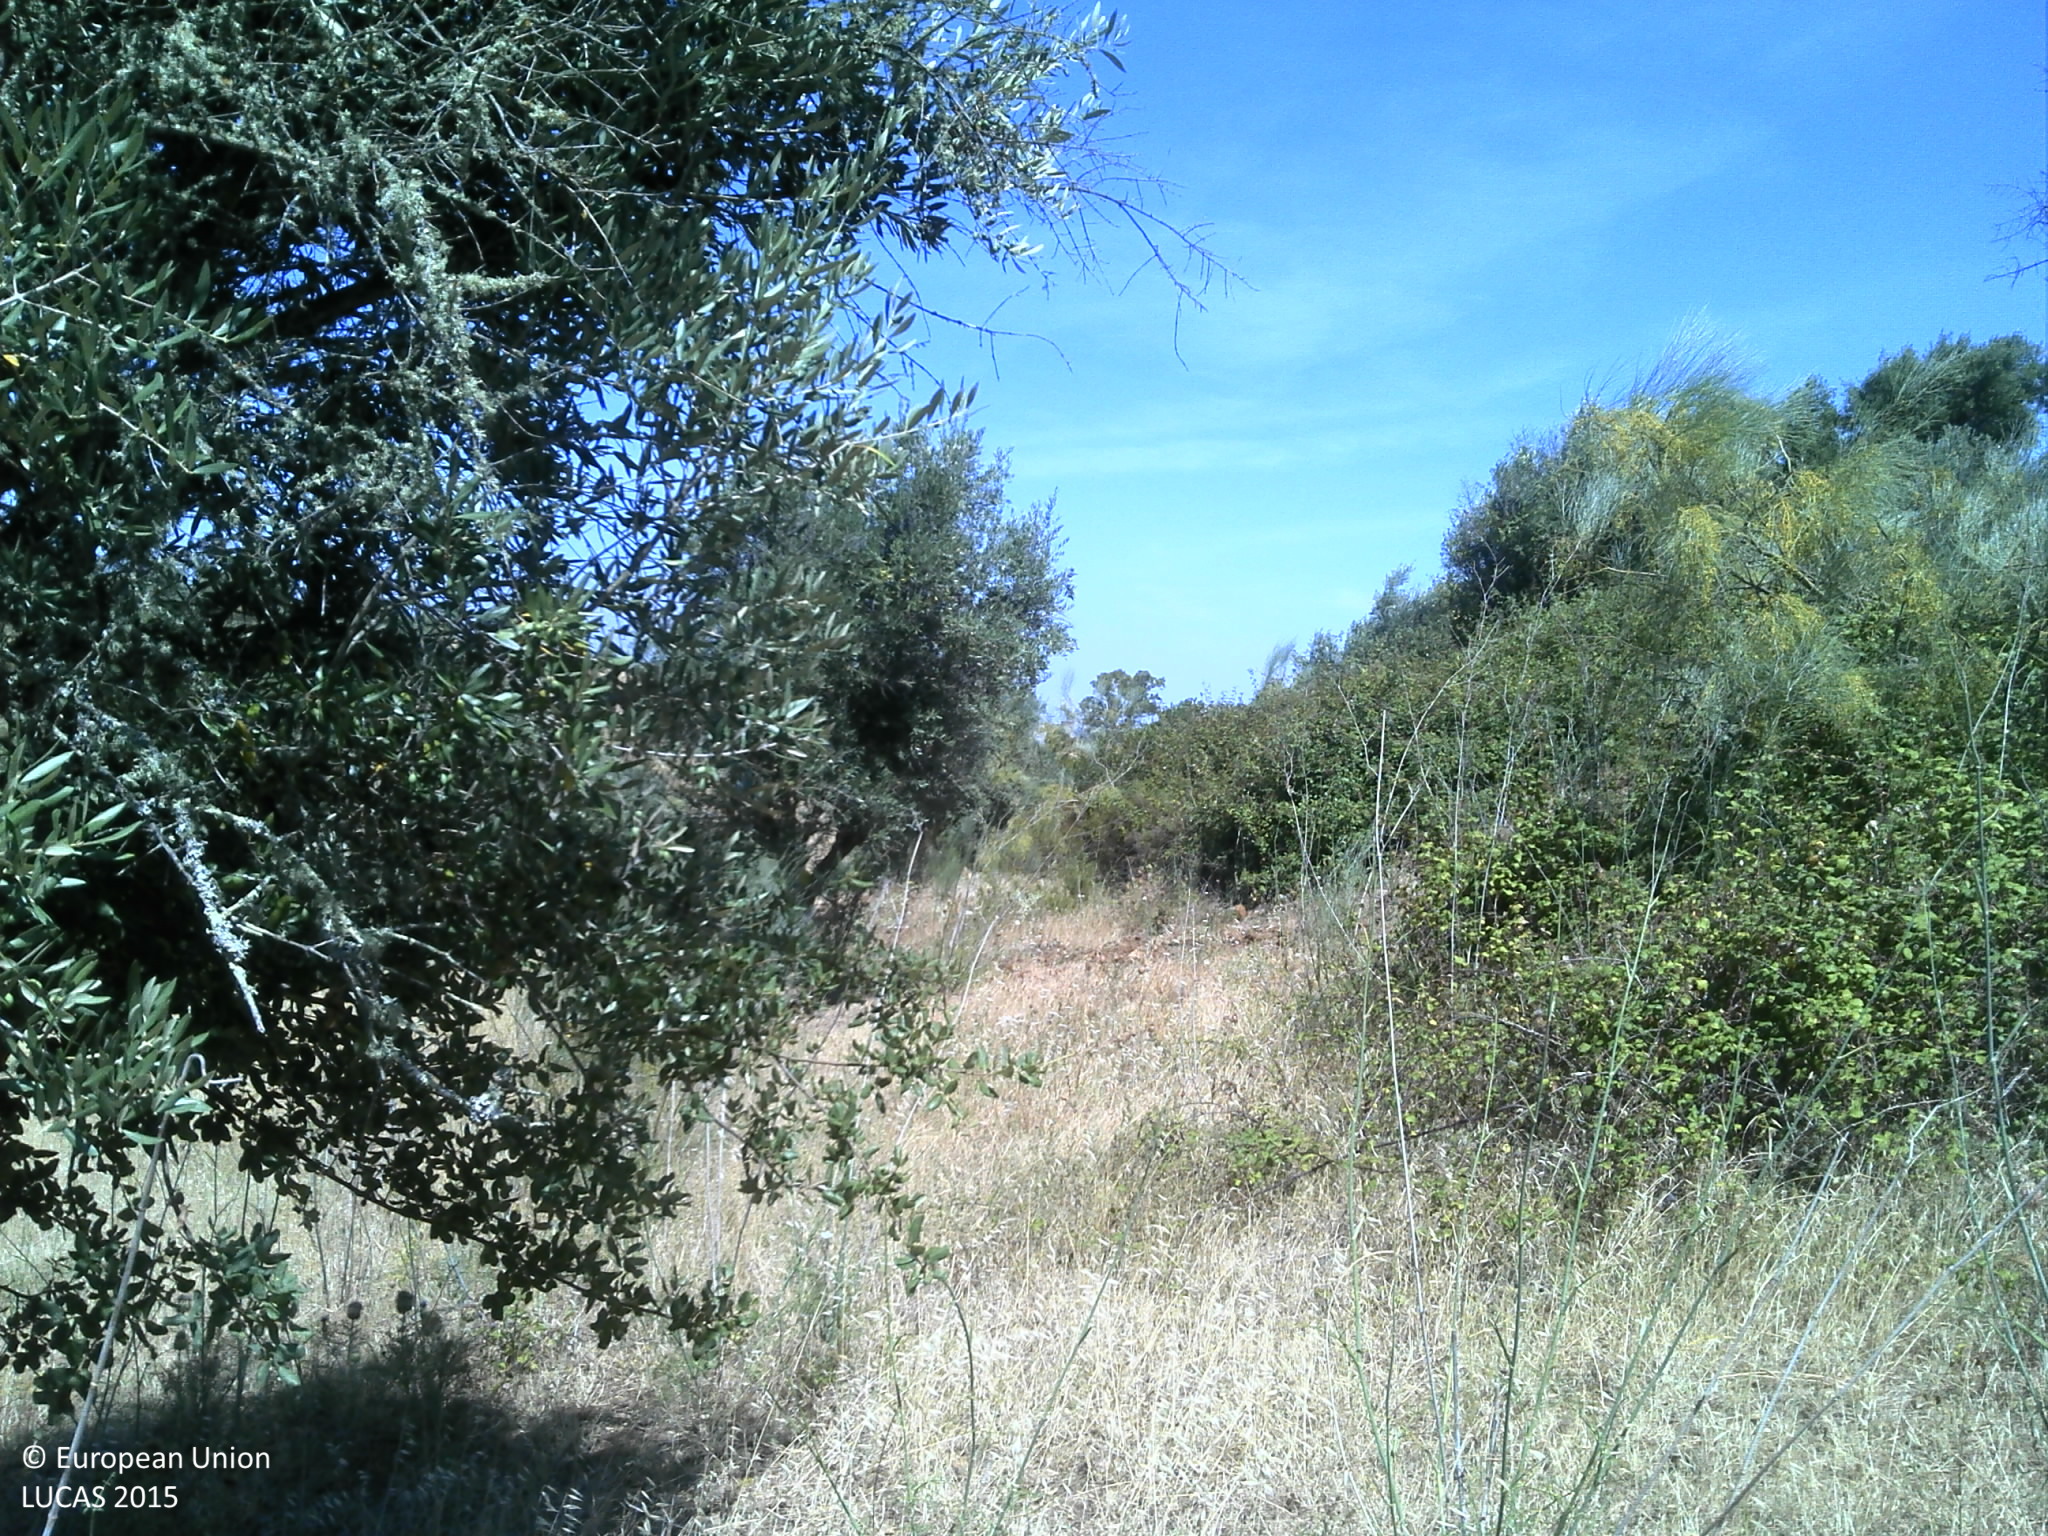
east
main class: Cropland
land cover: Olive groves
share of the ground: 25 - 50 %
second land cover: Grassland without tree/shrub cover
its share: 50 - 75 %
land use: Agriculture (excluding fallow land and kitchen gardens)
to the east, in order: Olive groves; Grassland without tree/shrub cover; Shruby margins; Fences; Olive groves; Fences; Other fresh vegetables; Fences; Olive groves; Oranges; Electric lines; Olive groves; Shruby margins; Ditches and canals; Grass margins; Olive groves
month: July
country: PT
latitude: 39.0684
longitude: -8.1903
